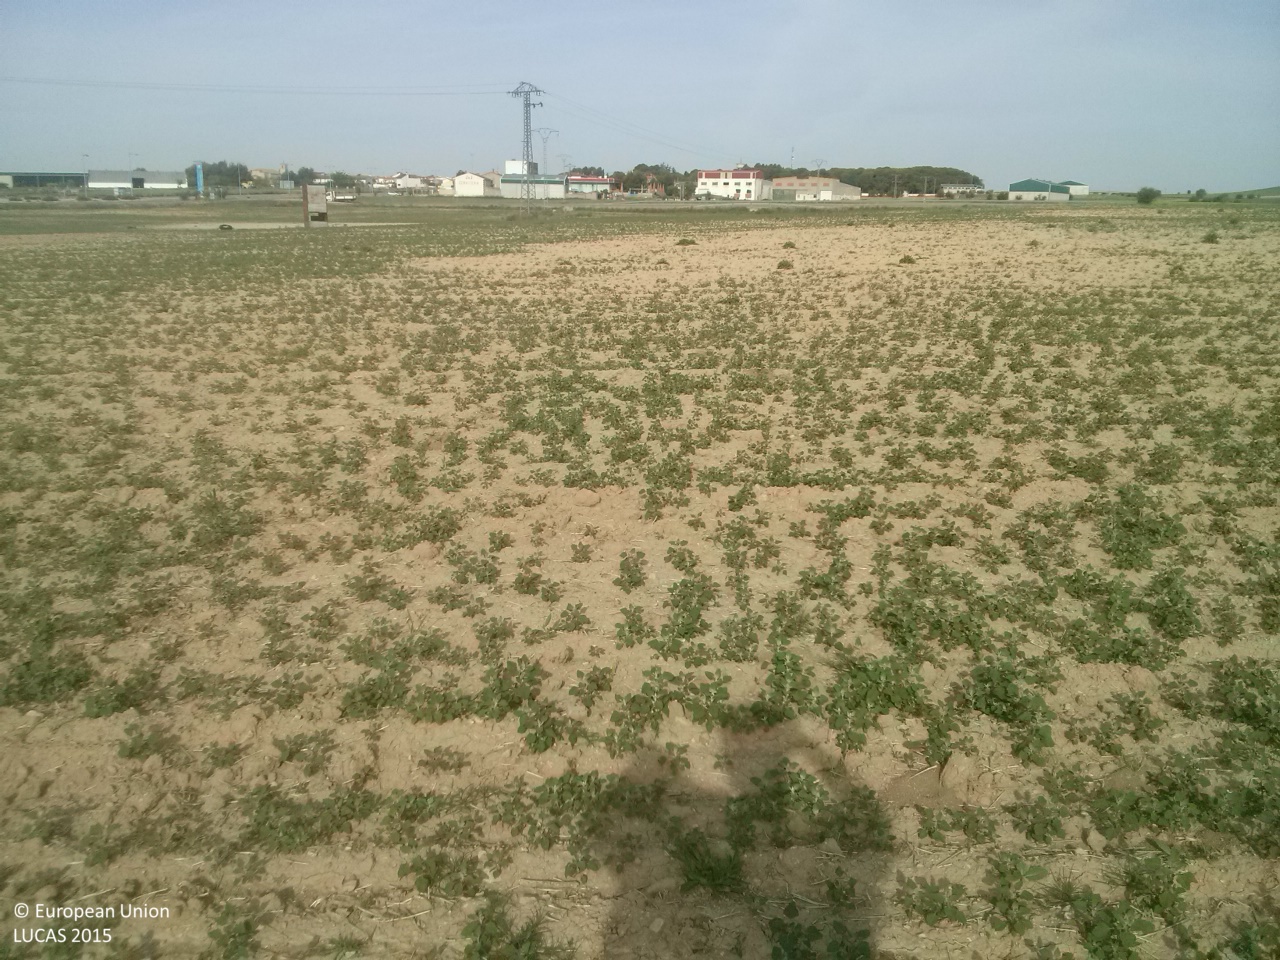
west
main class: Grassland
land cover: Spontaneously vegetated surfaces
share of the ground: 25 - 50 %
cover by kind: unconsolidated bare surface 75 %, herbaceous plants 25 %
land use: Fallow land
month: May
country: ES
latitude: 39.8827
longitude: -2.6590
